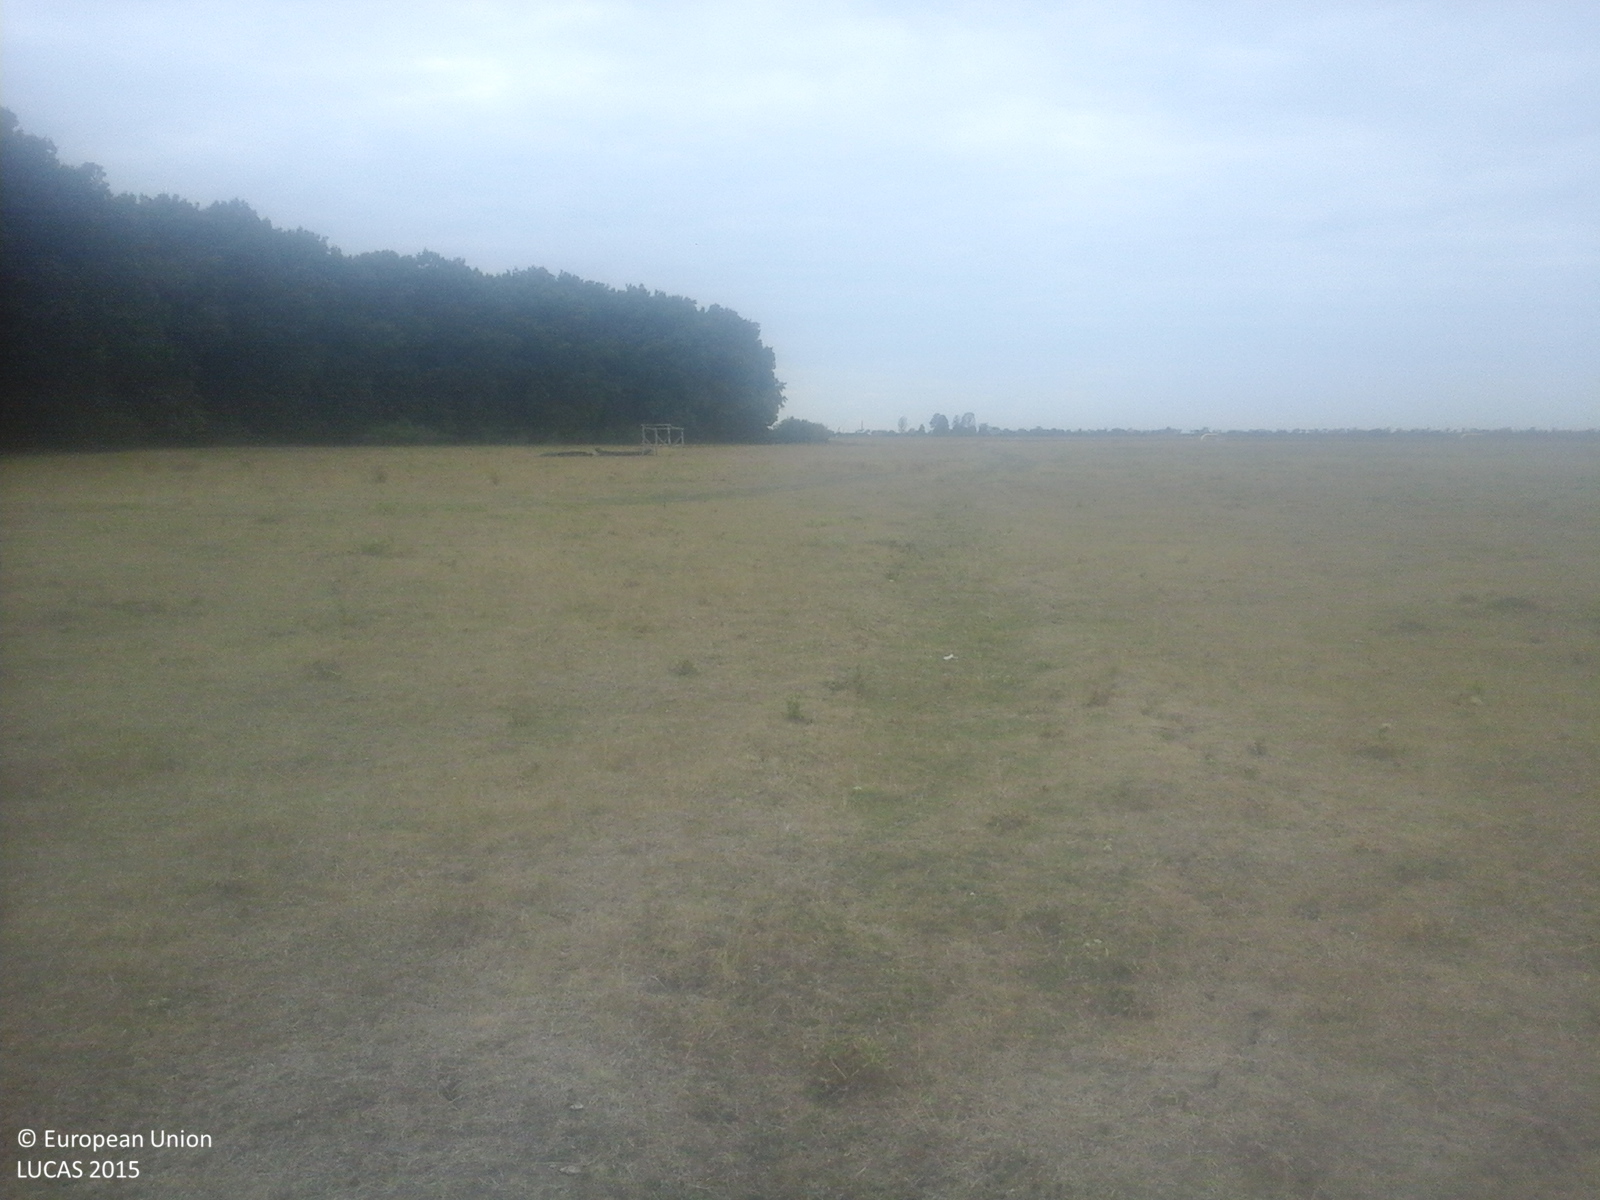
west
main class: Grassland
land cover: Grassland without tree/shrub cover
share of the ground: > 75 %
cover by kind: herbaceous plants 100 %
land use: Agriculture (excluding fallow land and kitchen gardens)
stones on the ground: < 10 %
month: September
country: RO
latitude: 47.7031
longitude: 22.7082
